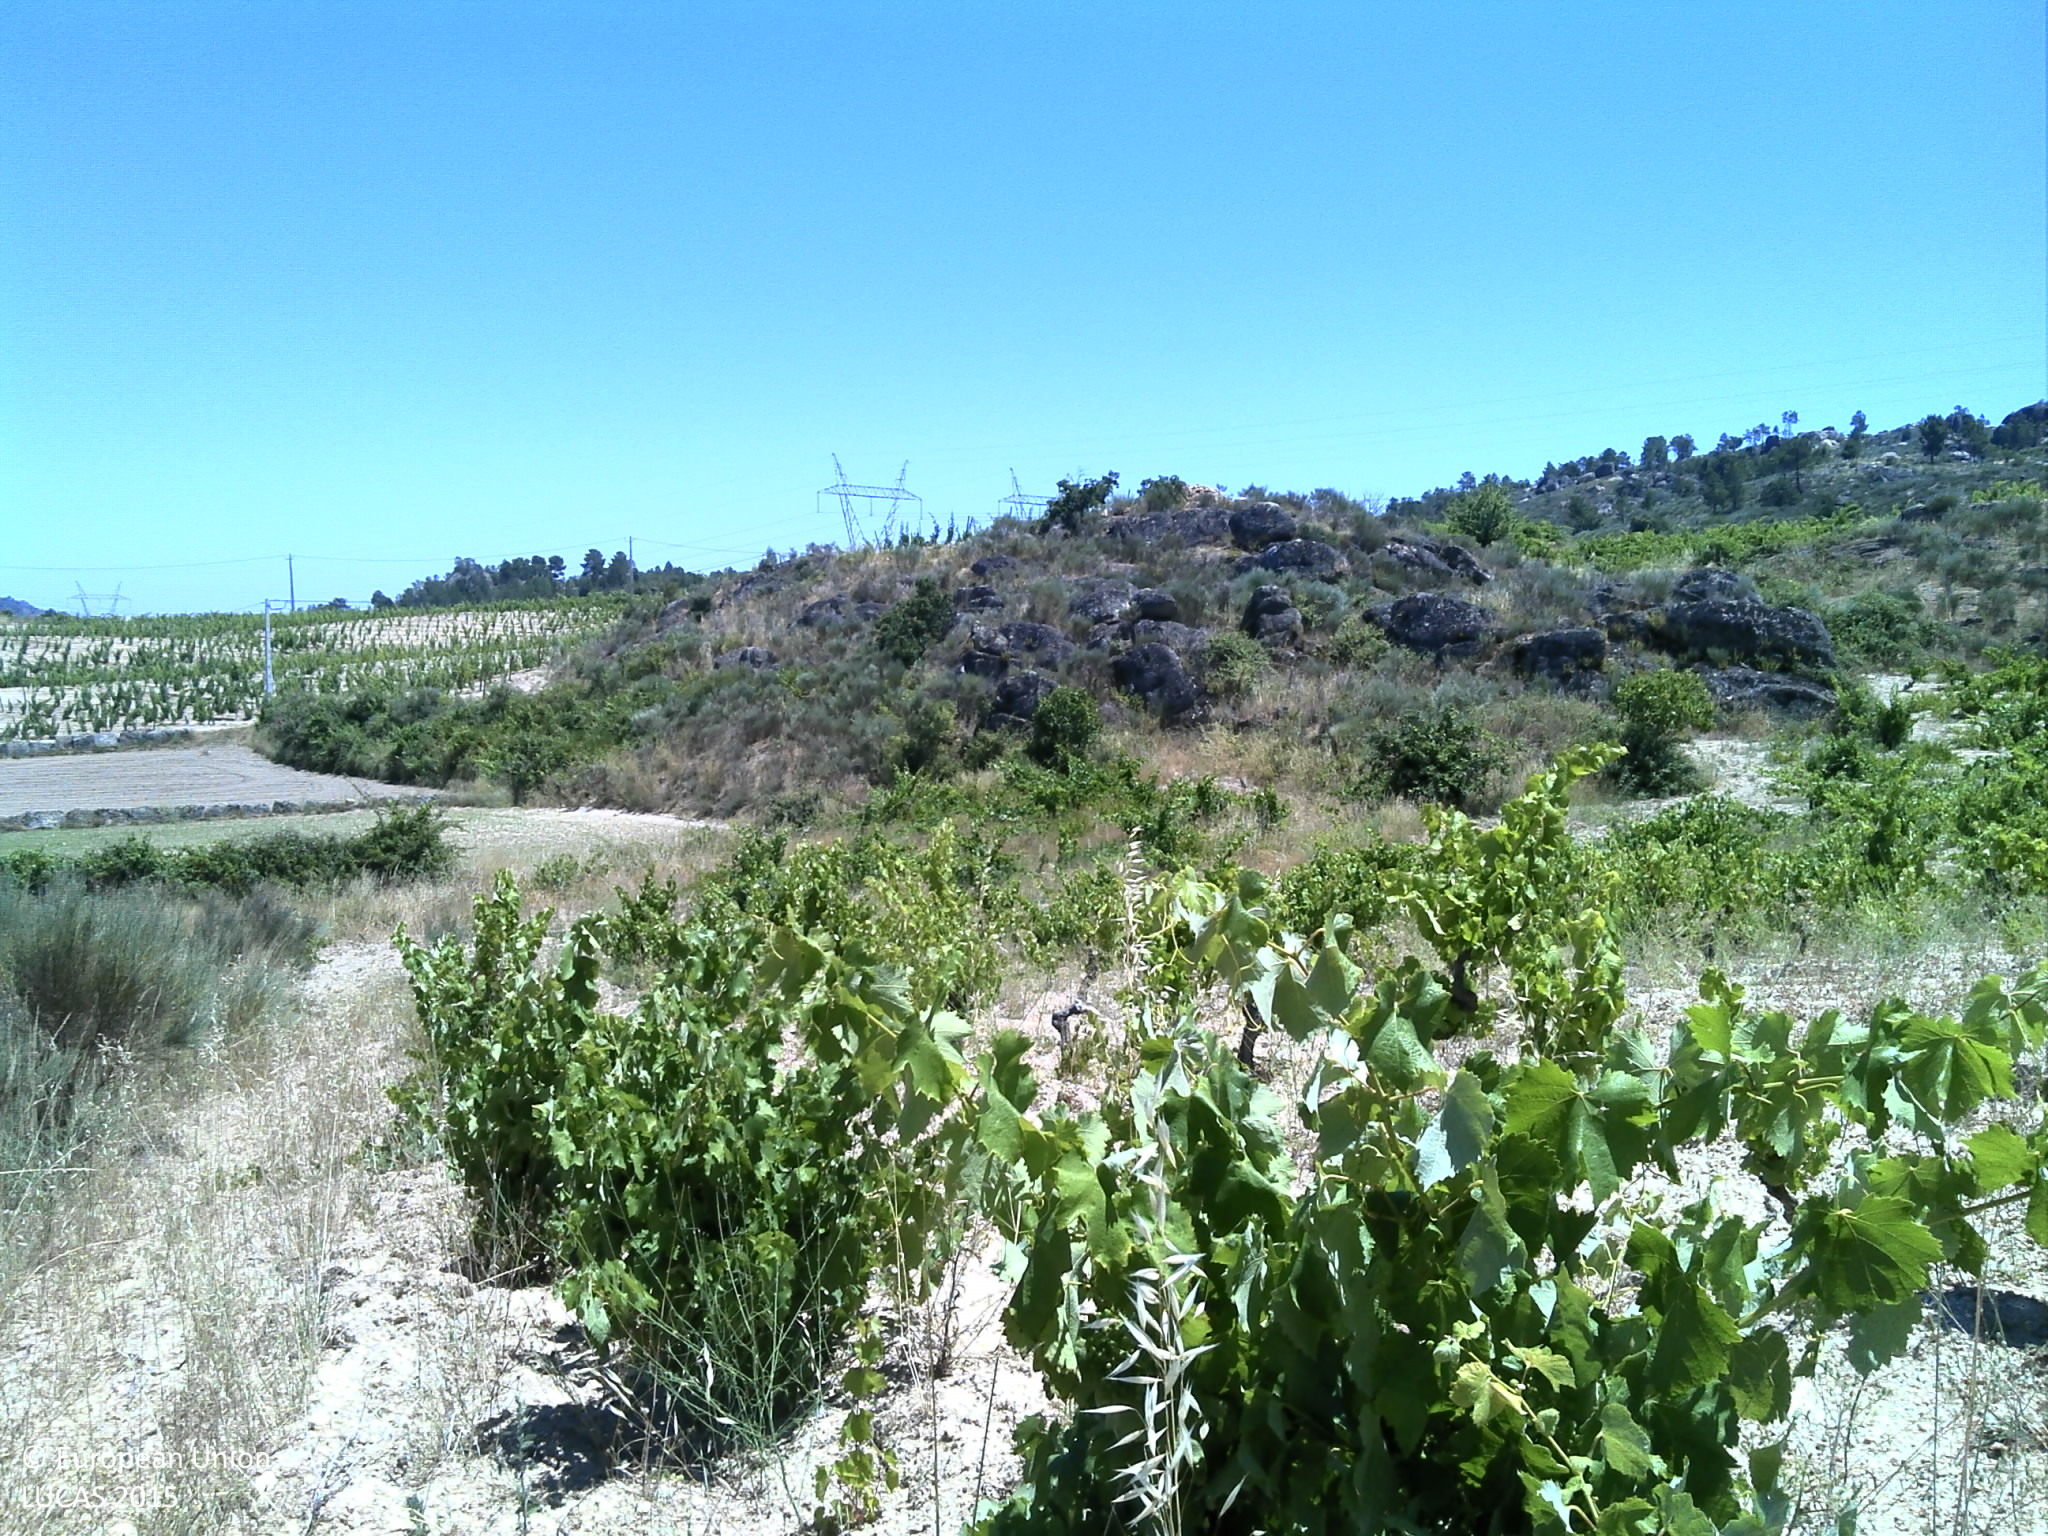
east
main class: Cropland
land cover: Vineyards
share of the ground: 10 - 25 %
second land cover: Grassland without tree/shrub cover
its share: 10 - 25 %
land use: Agriculture (excluding fallow land and kitchen gardens)
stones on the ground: > 50 %
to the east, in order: Vineyards; Grassland without tree/shrub cover; Vineyards; Tracks; Other fruit trees and berries; Grassland without tree/shrub cover; Rock outcrops; Vineyards; Shruby margins; Tracks; Rock outcrops; Grassland without tree/shrub cover; Rock outcrops; Vineyards; Tracks; Grass margins; Grassland with sparse tree/shrub cover; Shruby margins; Dry stone walls; Vineyards; Electric lines; Vineyards; Electric lines; Vineyards
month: June
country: PT
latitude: 40.8826
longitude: -7.2598
